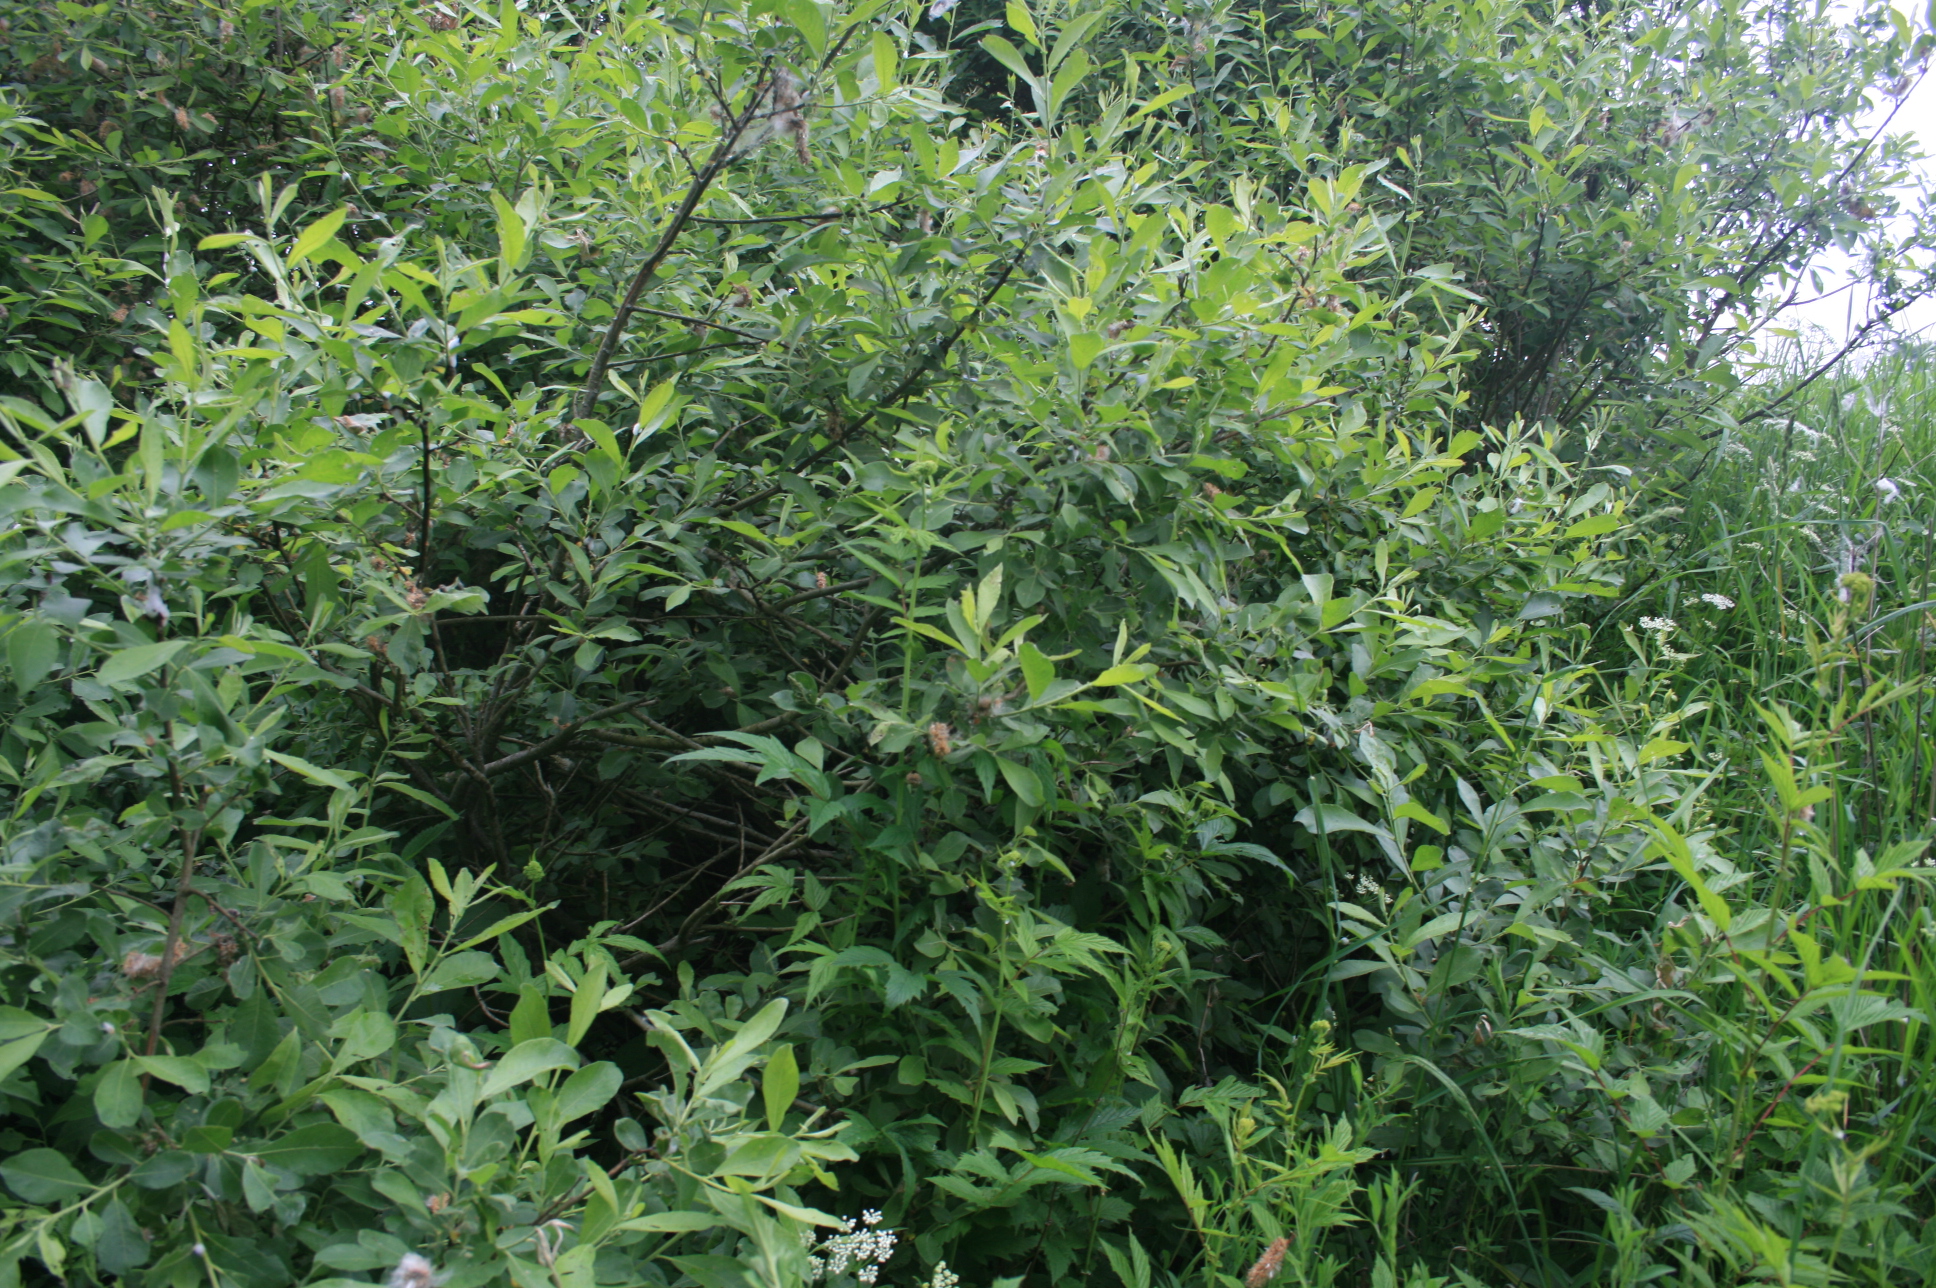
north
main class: Woodland
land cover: Broadleaved woodland
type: non-riverine alder, birch or aspen forest
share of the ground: > 75 %
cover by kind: broadleaved forest trees 90 %, herbaceous plants 10 %
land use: Semi-natural and natural areas not in use
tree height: > 5 m
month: June
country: LT
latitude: 55.7062
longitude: 22.2625
